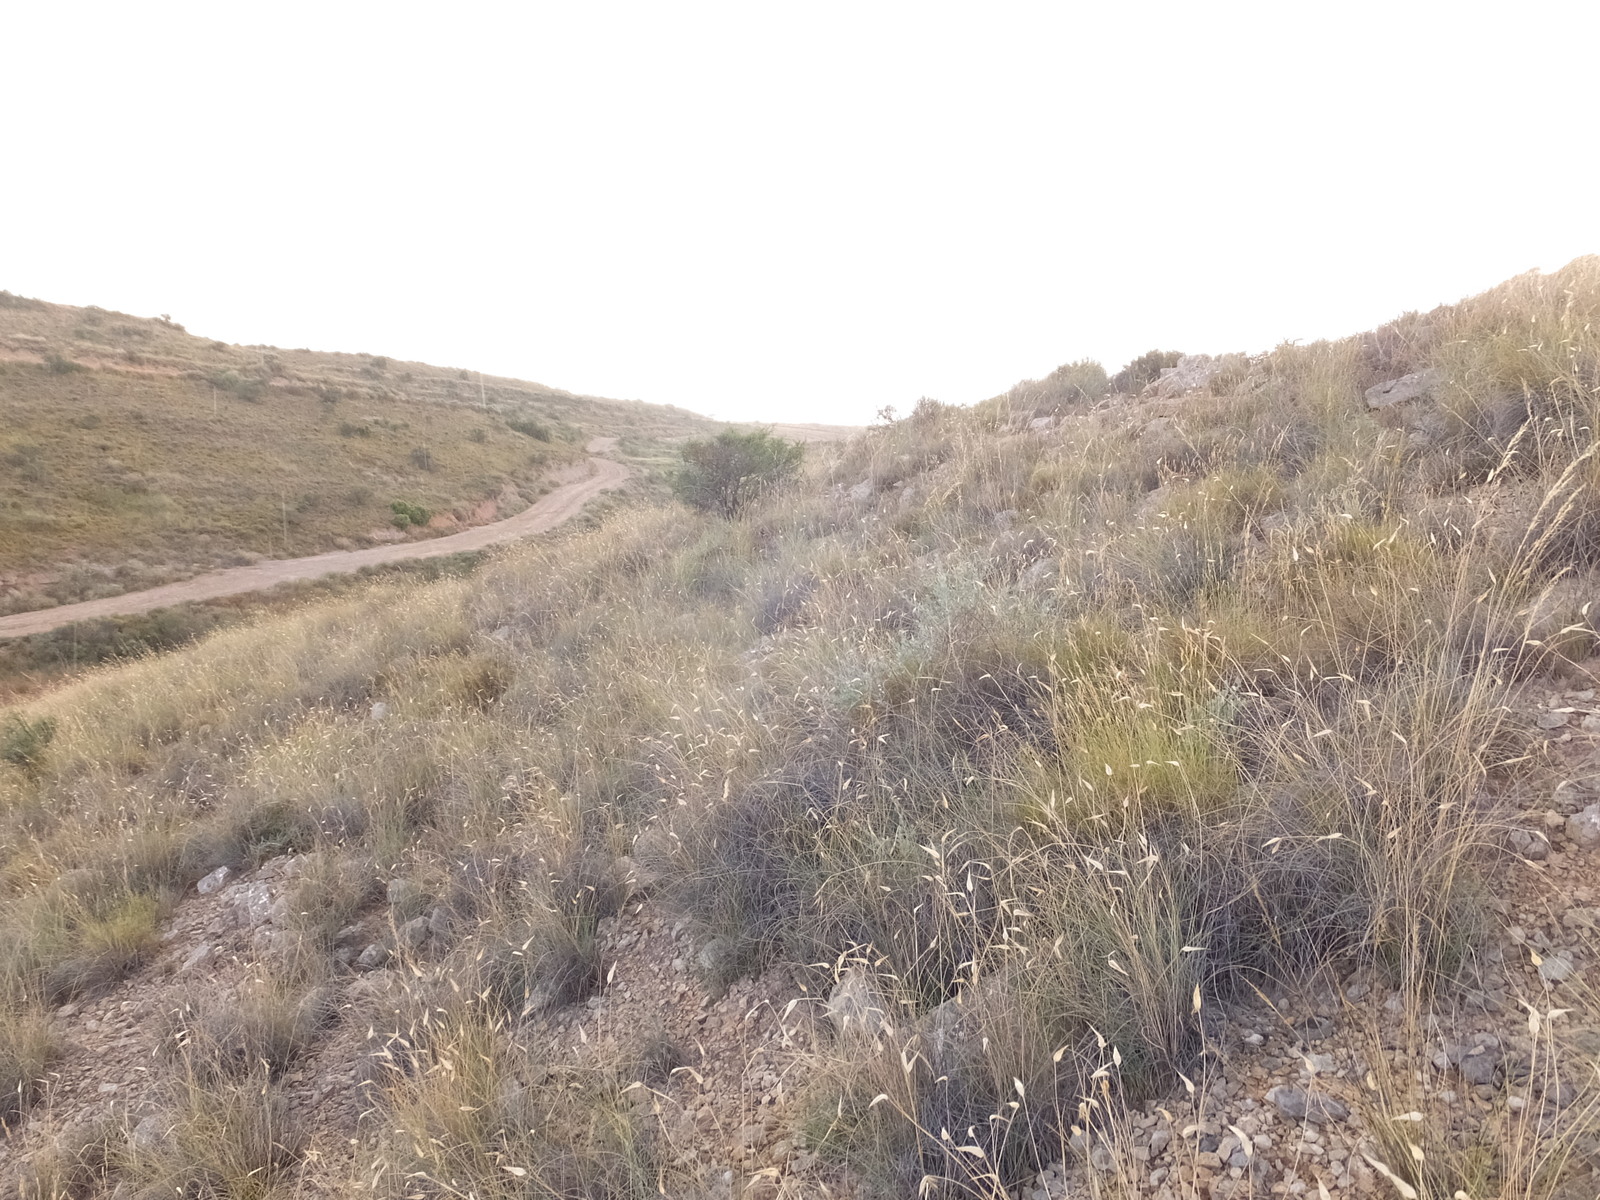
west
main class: Shrubland
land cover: Shrubland without tree cover
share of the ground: 50 - 75 %
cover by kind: shrubs 50 %, herbaceous plants 40 %, consolidated bare surface 10 %
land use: Semi-natural and natural areas not in use
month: June
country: ES
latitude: 41.6696
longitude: 0.0272
